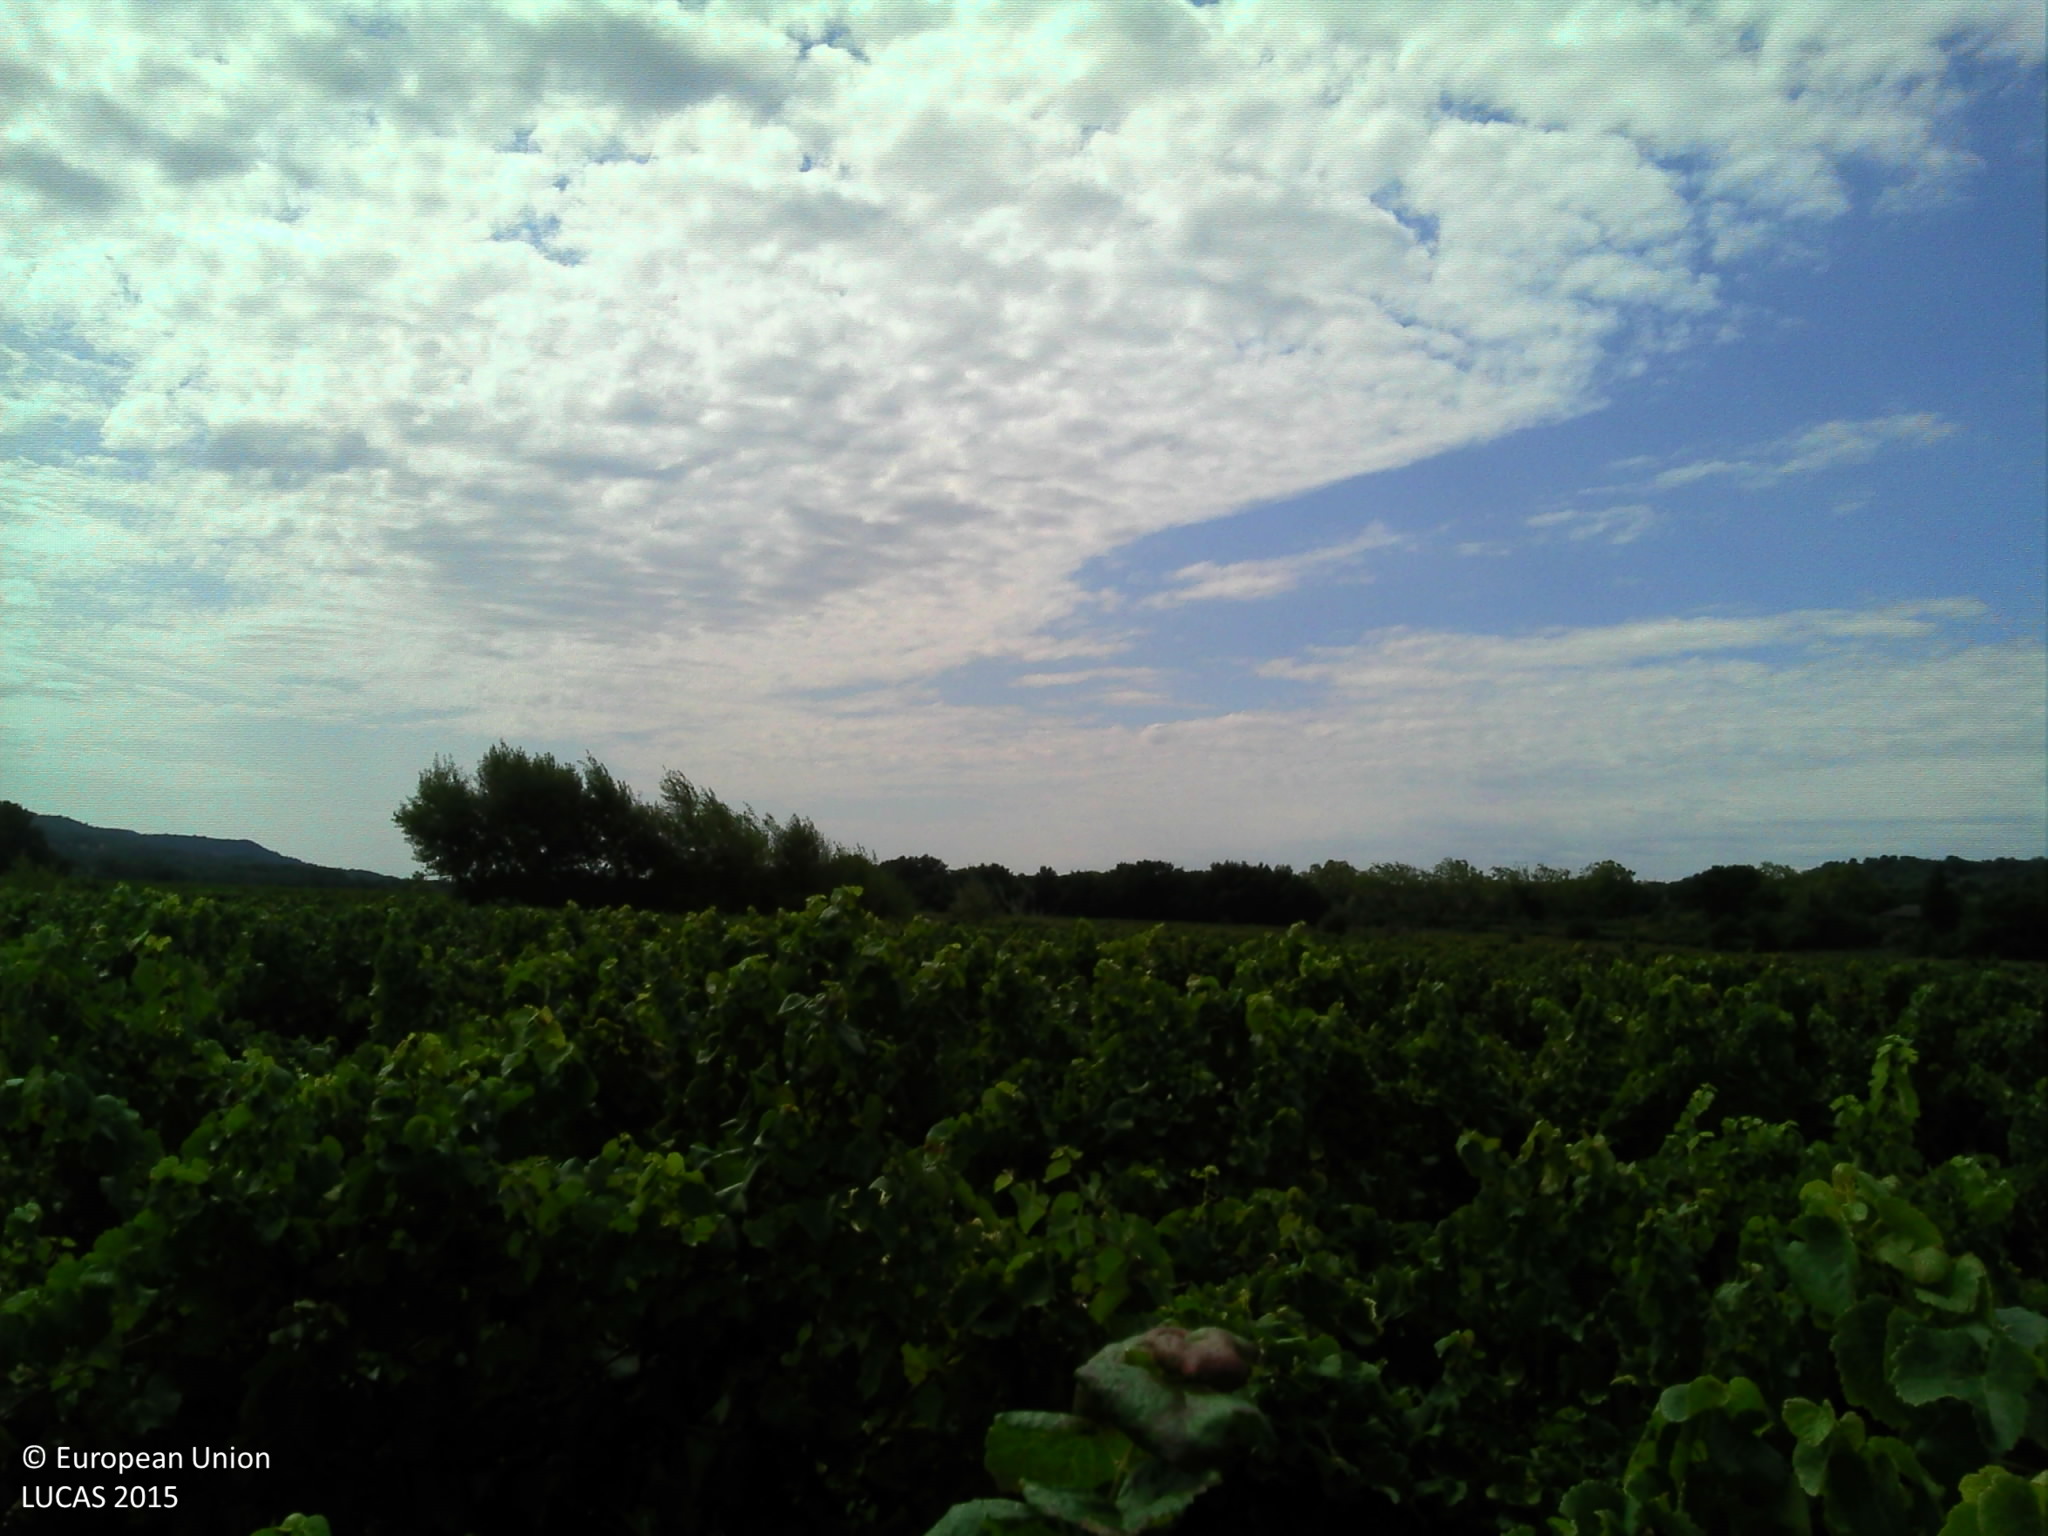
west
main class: Cropland
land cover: Vineyards
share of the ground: 10 - 25 %
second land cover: Grassland without tree/shrub cover
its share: > 75 %
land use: Agriculture (excluding fallow land and kitchen gardens)
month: September
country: FR
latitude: 44.3038
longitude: 5.0311
